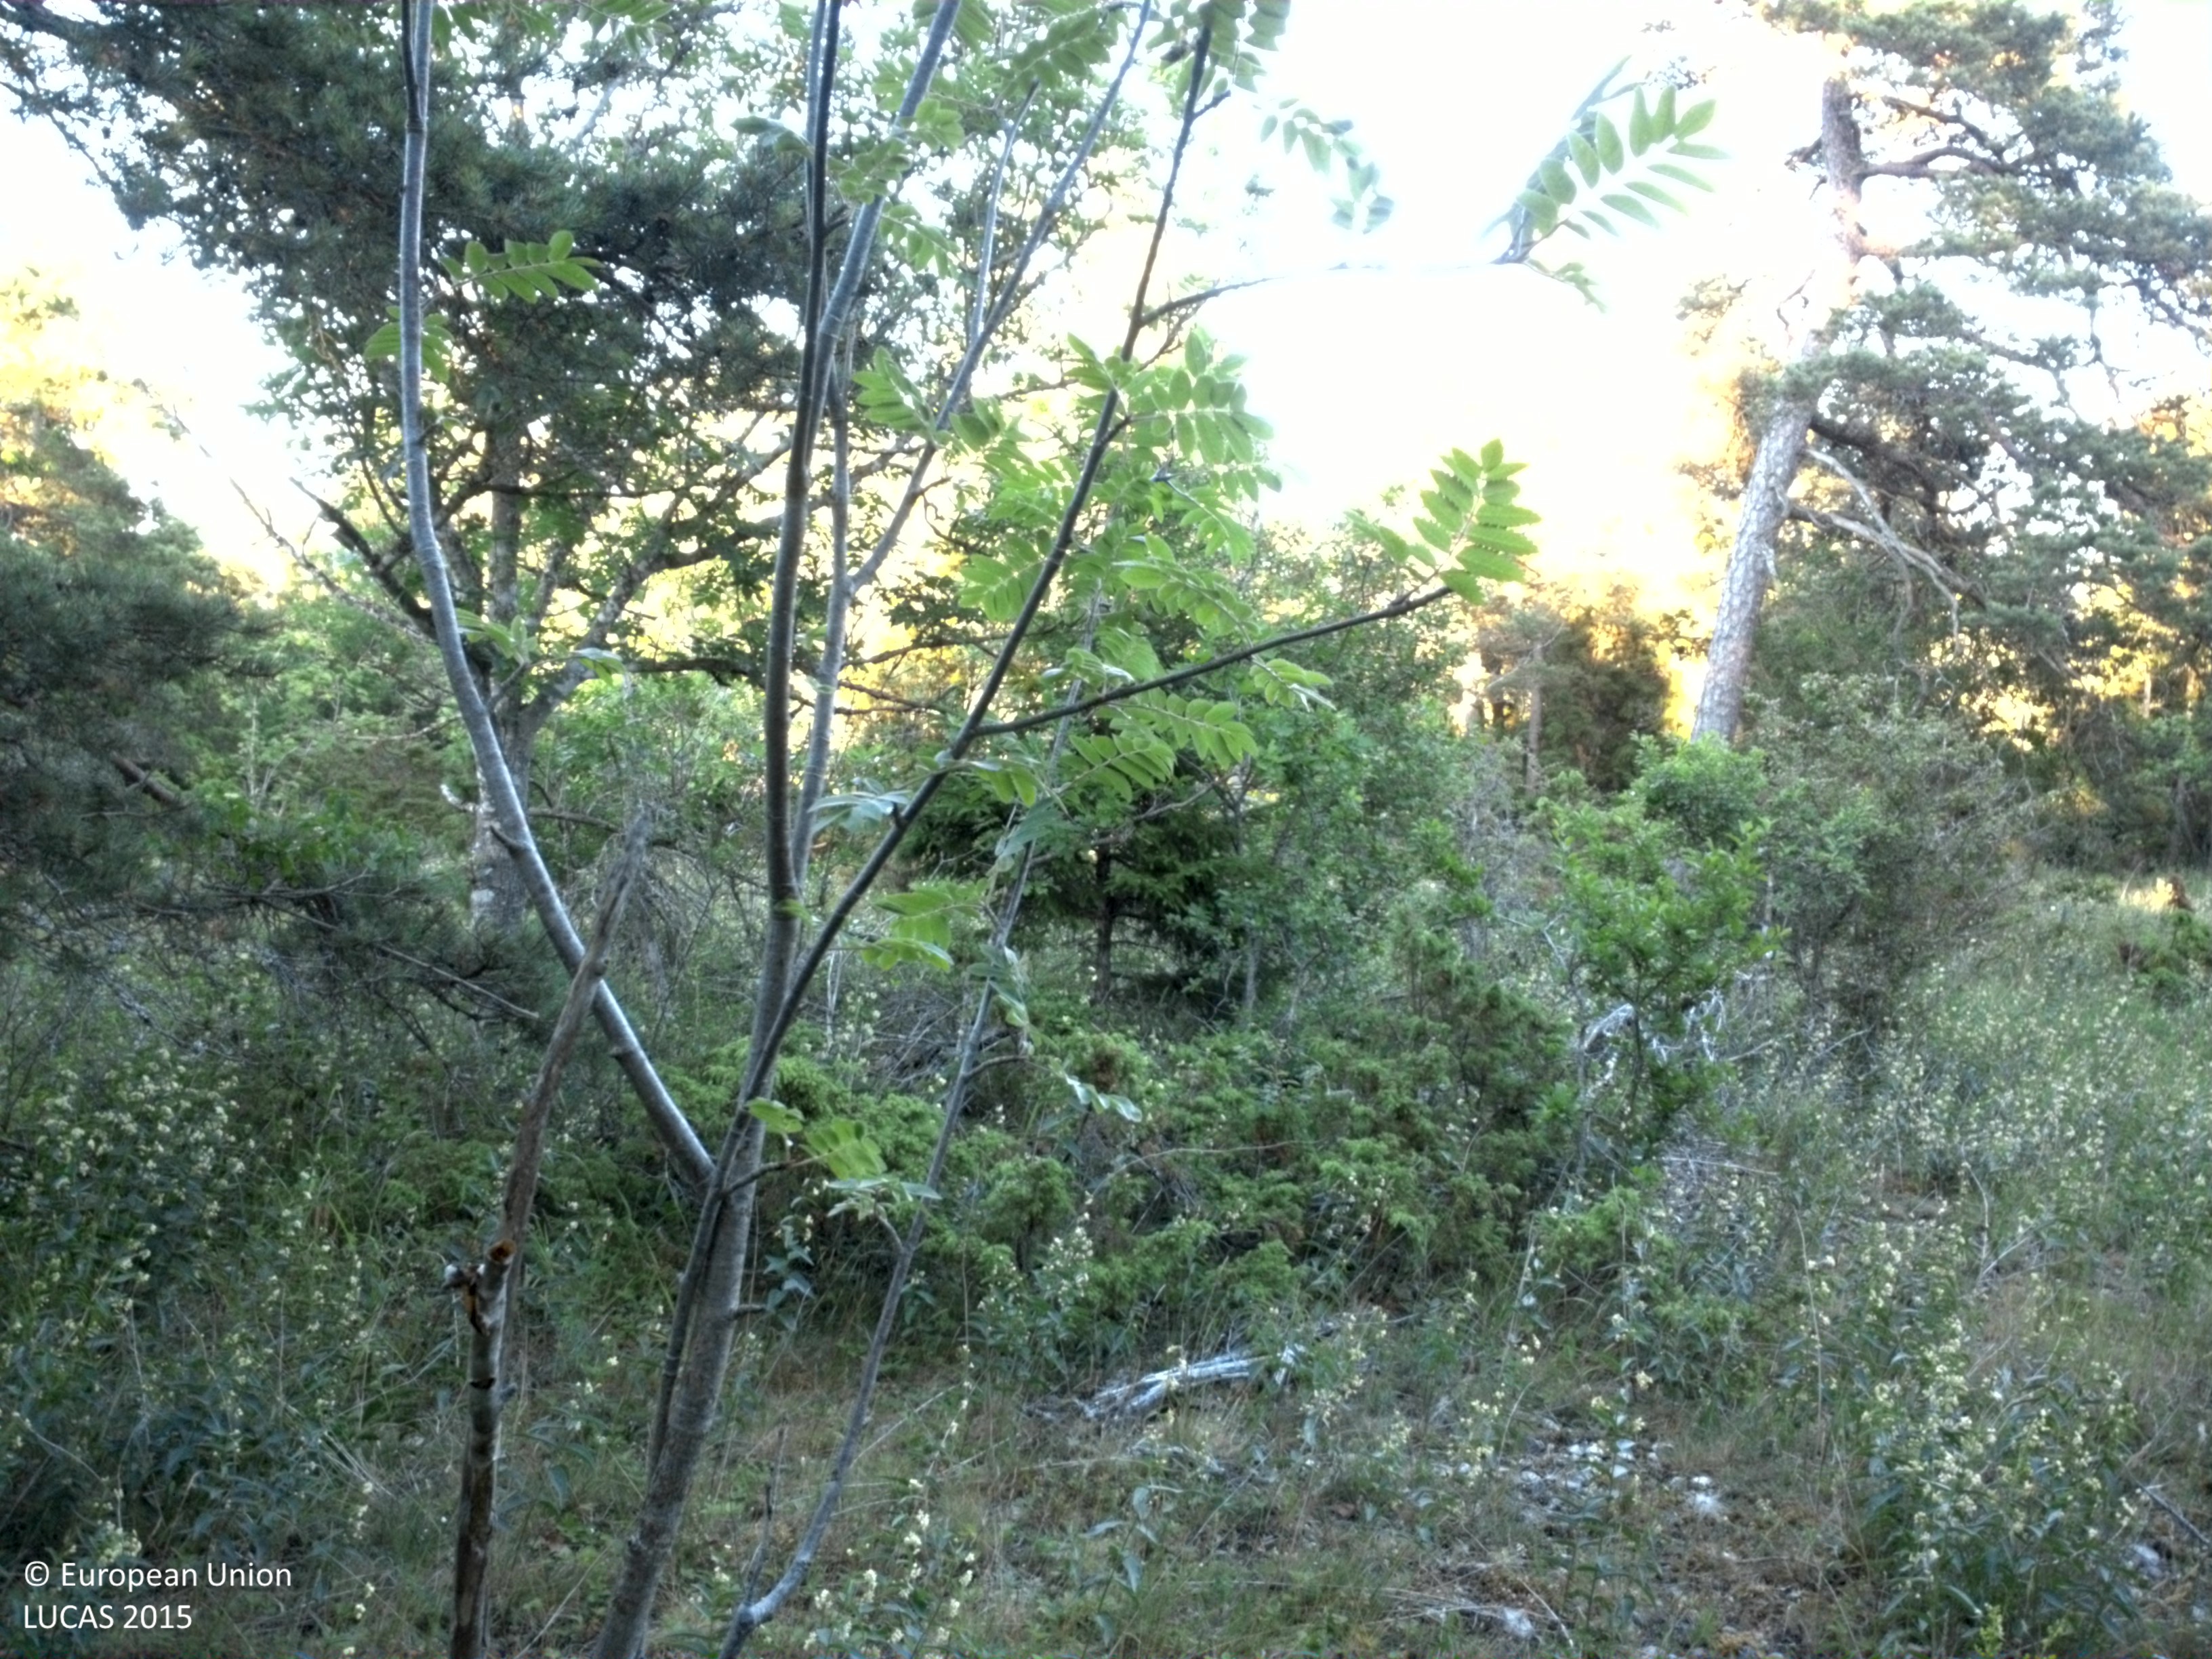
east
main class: Woodland
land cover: Pine dominated coniferous woodland
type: hemiboreal forest and nemoral coniferous forest and mixed broadleaved-coniferous forest
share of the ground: > 75 %
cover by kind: coniferous forest trees 80 %, herbaceous plants 10 %, broadleaved forest trees 5 %, shrubs 5 %
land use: Forestry
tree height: > 5 m
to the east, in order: Pine dominated coniferous woodland; Paved roads, cycling and walking lanes; Electric lines; Fences; Pine dominated coniferous woodland
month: July
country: SE
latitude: 57.7497
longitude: 18.7972
